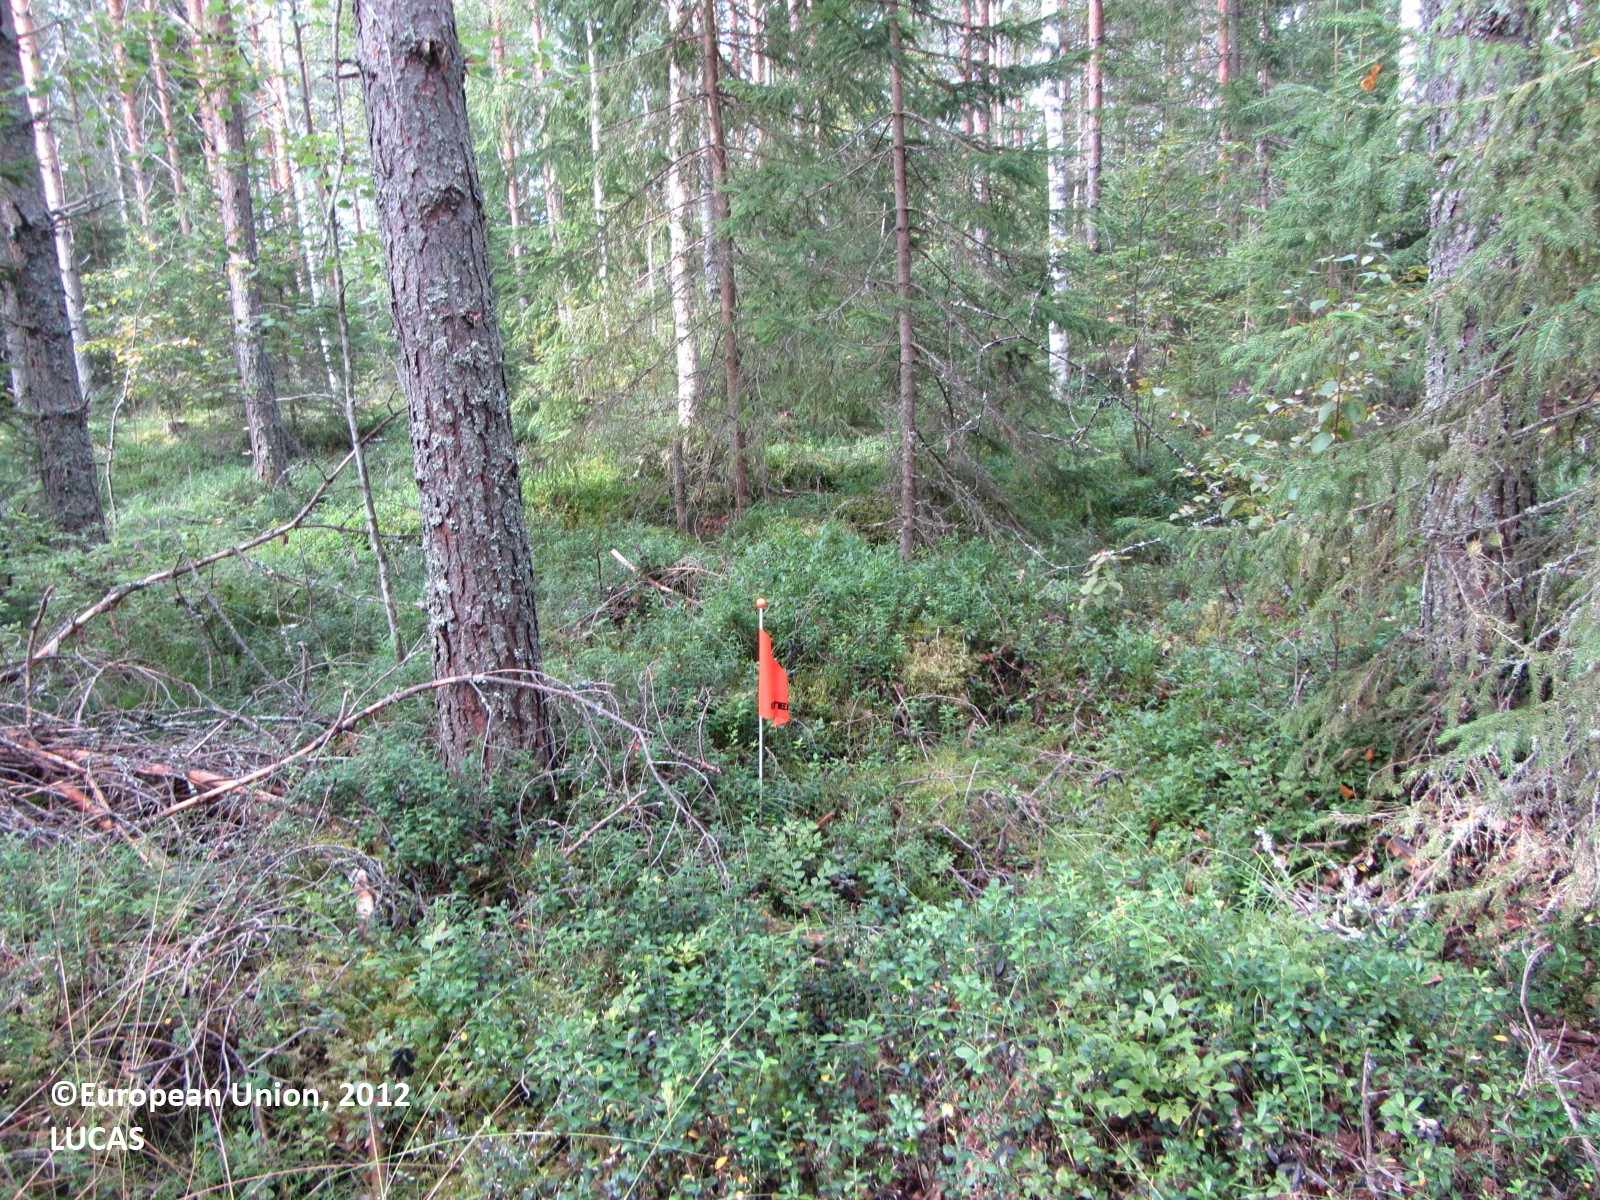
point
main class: Woodland
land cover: Pine dominated mixed woodland
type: boreal forest
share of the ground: > 75 %
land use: Forestry
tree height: > 5 m
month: August
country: FI
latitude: 63.0069
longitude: 25.0861
